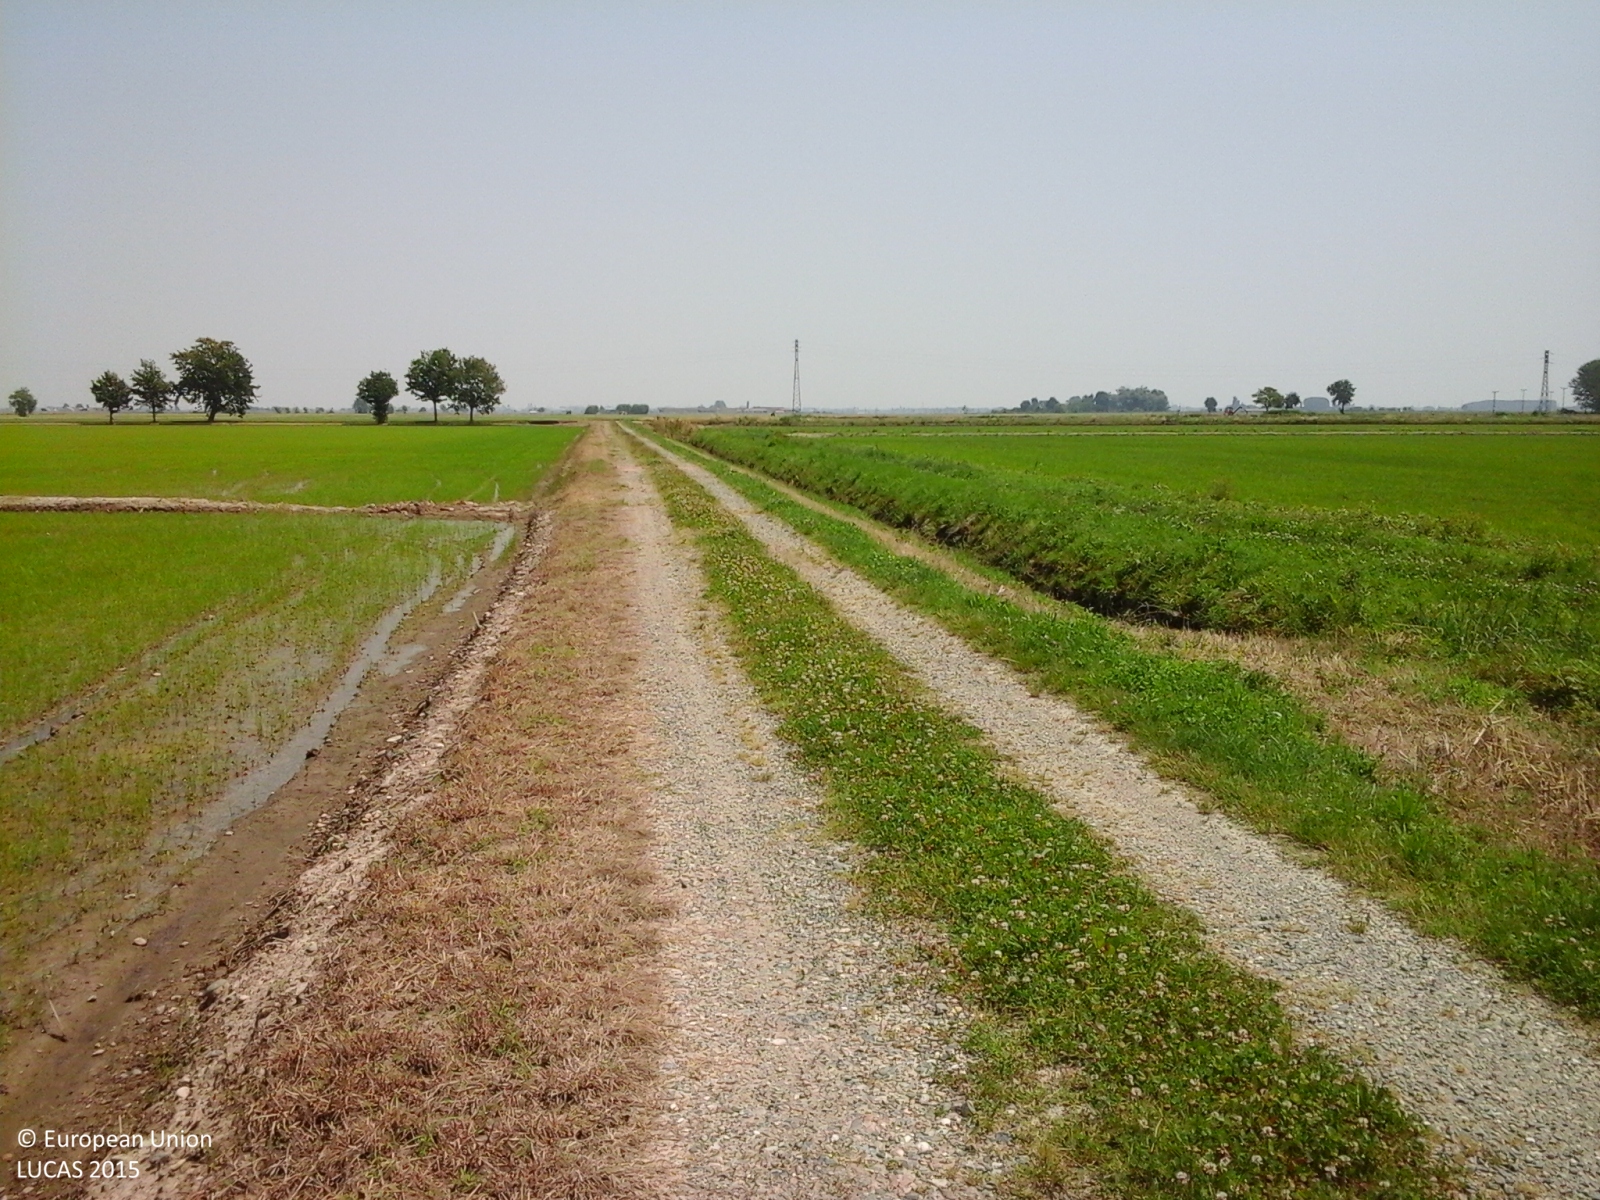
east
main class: Cropland
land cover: Rice
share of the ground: 25 - 50 %
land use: Agriculture (excluding fallow land and kitchen gardens)
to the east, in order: Rice; Other structural elements; Rice
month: May
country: IT
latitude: 45.3286
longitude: 8.3060
